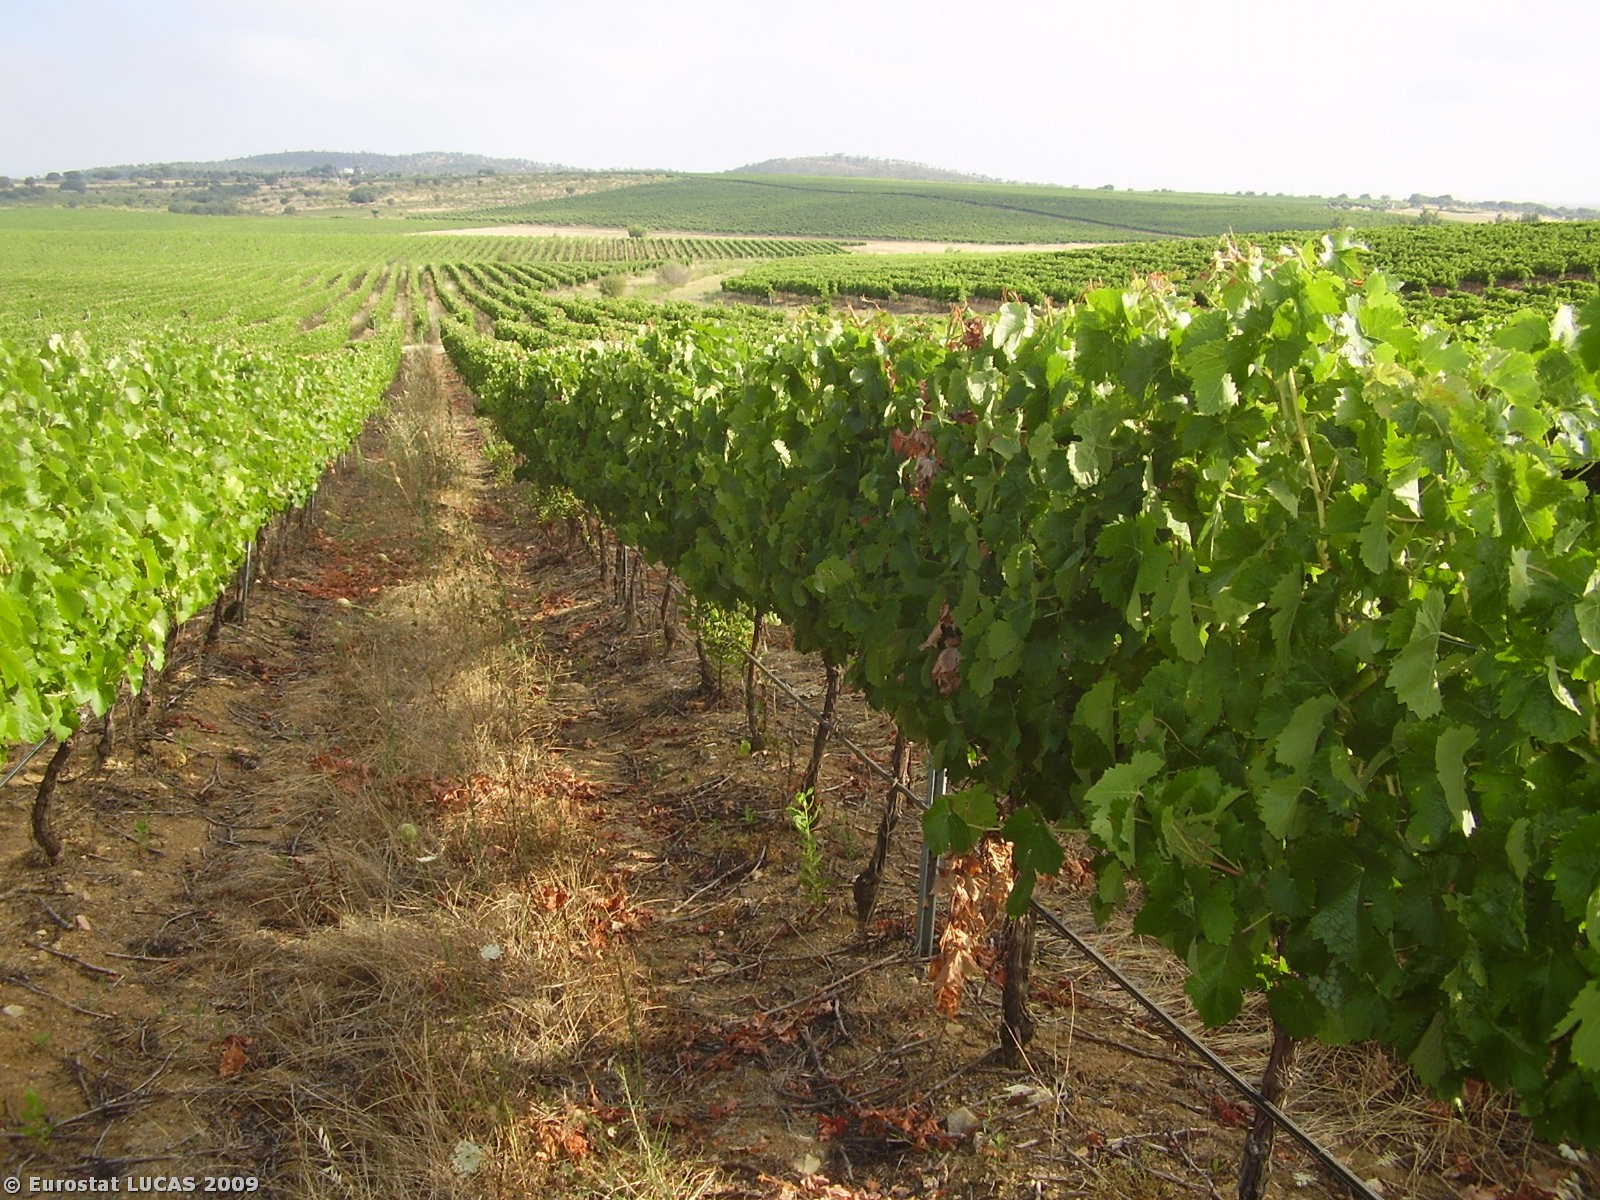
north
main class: Cropland
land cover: Vineyards
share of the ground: 25 - 50 %
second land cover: Spontaneously vegetated surfaces
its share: 50 - 75 %
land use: Agriculture (excluding fallow land and kitchen gardens)
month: July
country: PT
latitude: 38.7823
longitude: -7.9448
